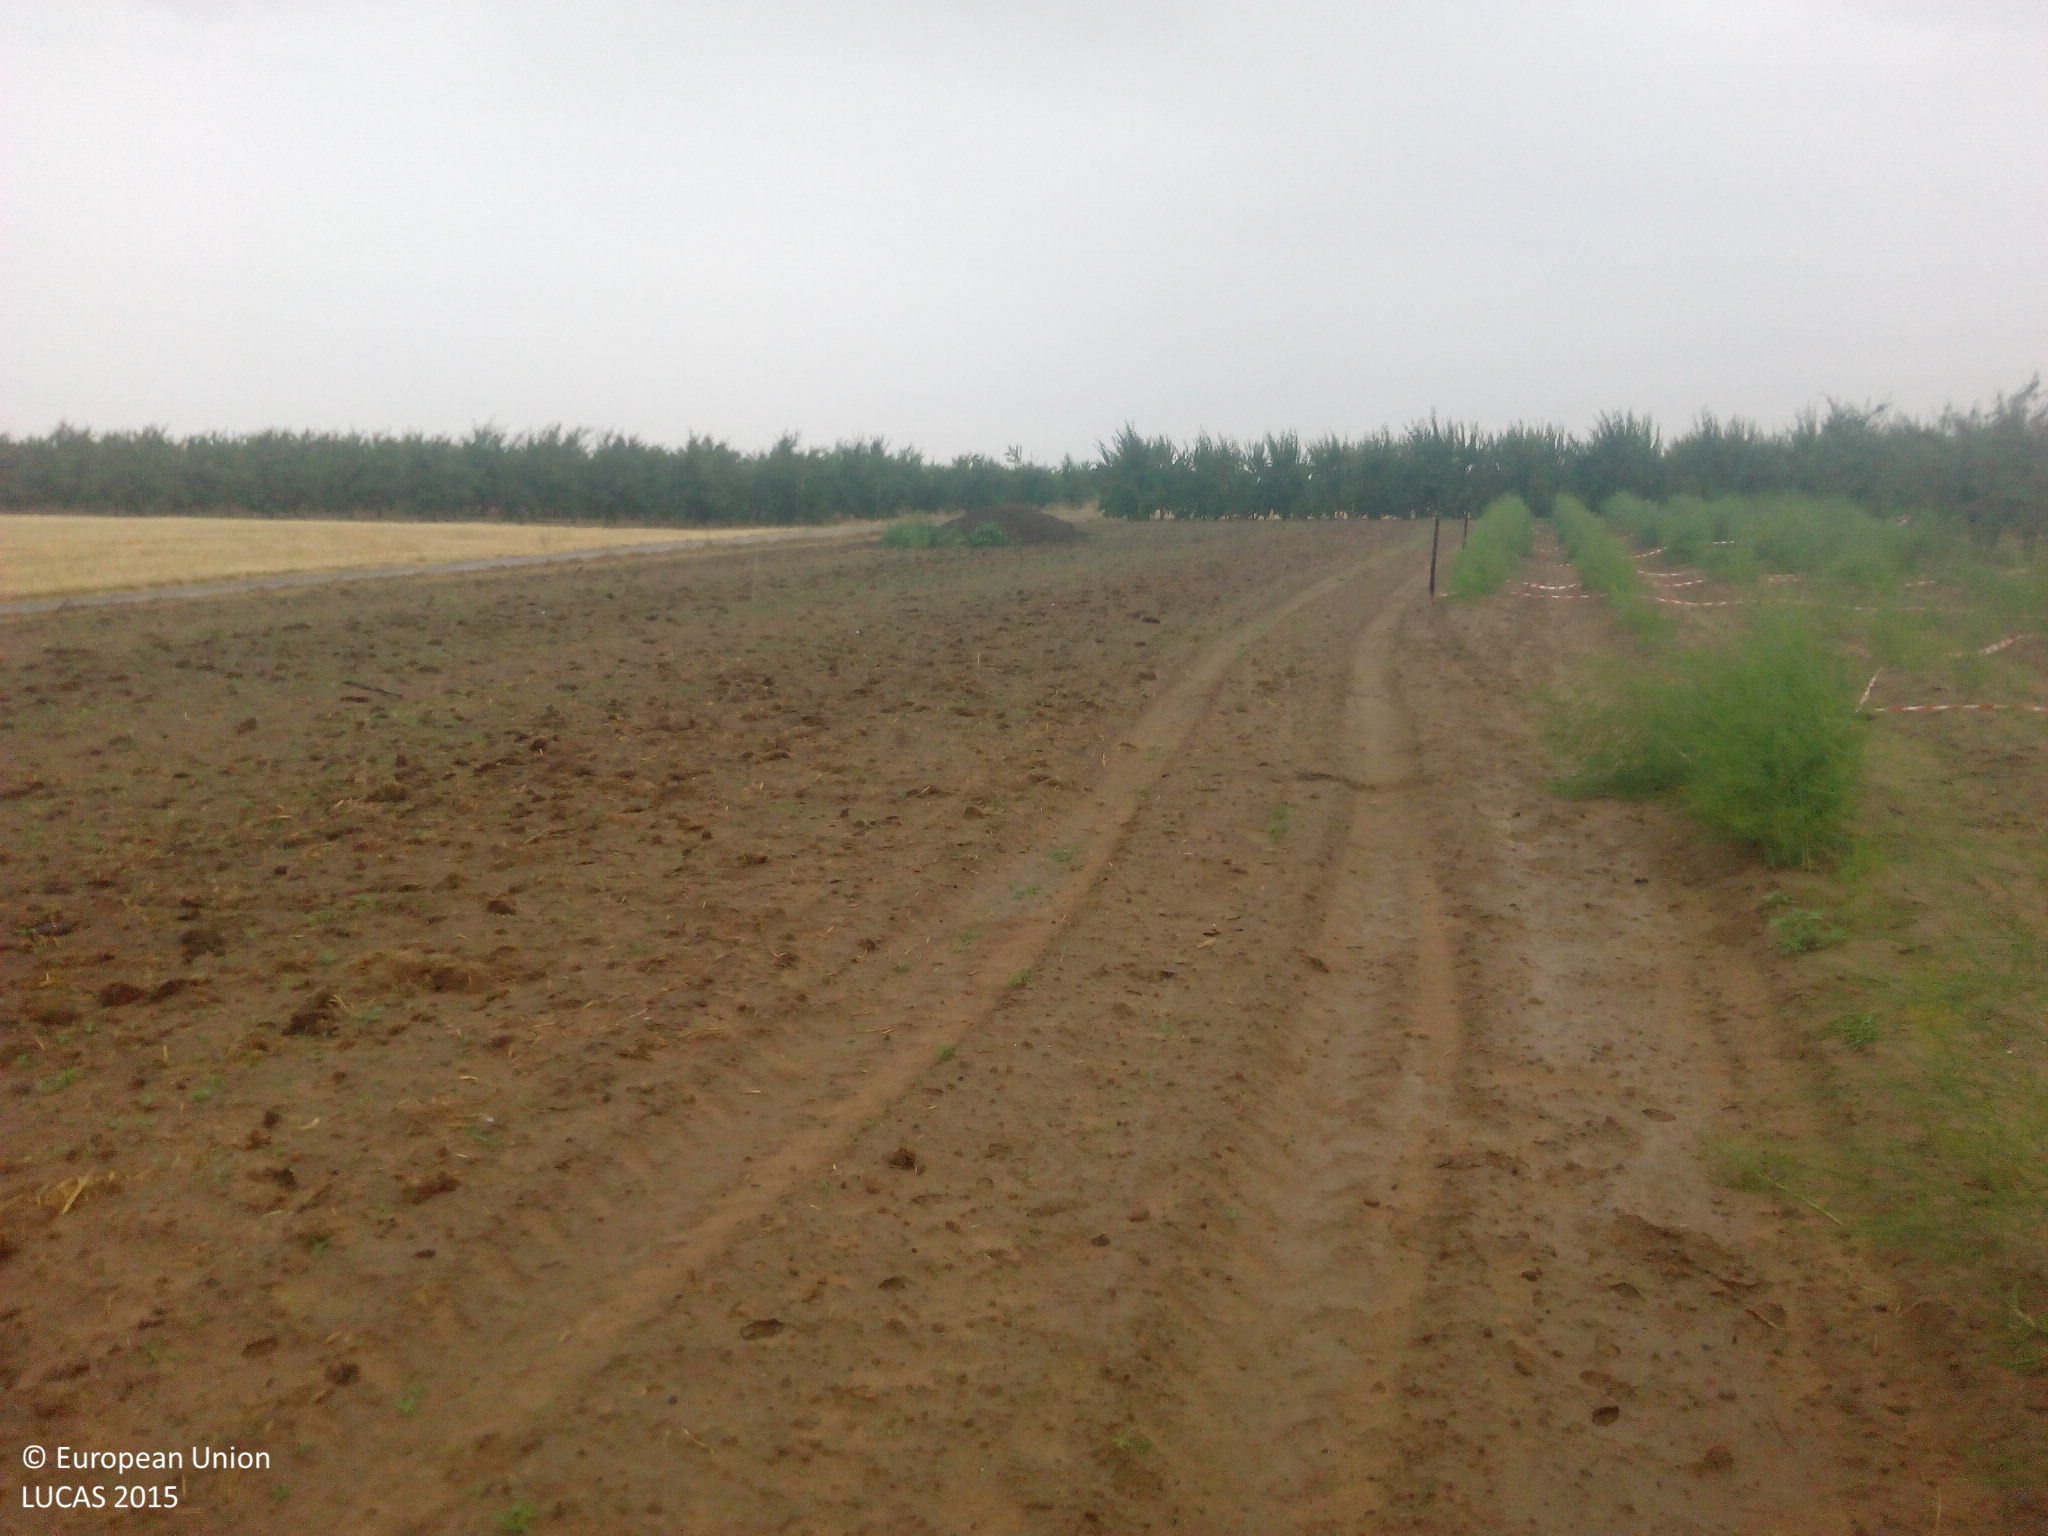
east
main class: Cropland
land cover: Common wheat
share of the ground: < 10 %
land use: Agriculture (excluding fallow land and kitchen gardens)
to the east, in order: Common wheat; Tracks; Common wheat; Grass margins; Other fruit trees and berries; Grass margins; Tracks; Fences; Other fruit trees and berries; Grassland without tree/shrub cover; Tracks; Apple fruit; Grass margins; Fences; Barley
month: August
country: DE
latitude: 49.9893
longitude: 8.1453
